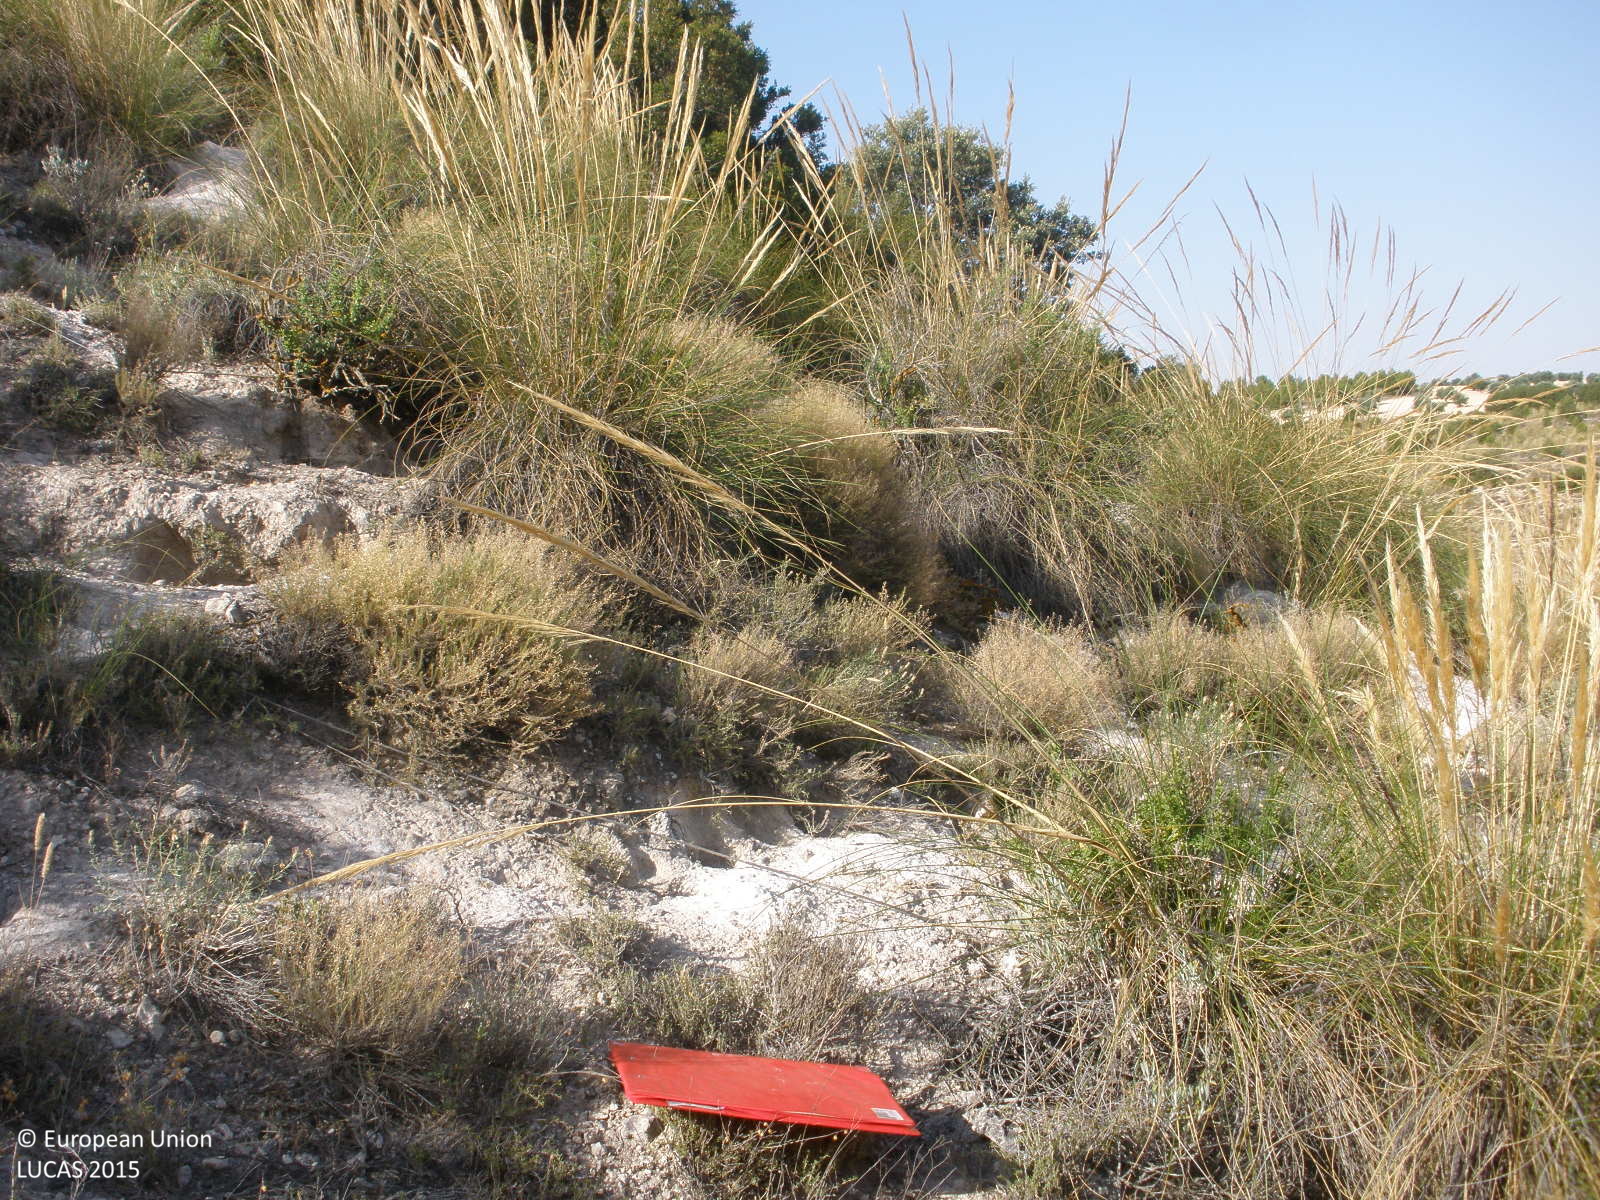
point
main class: Shrubland
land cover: Shrubland without tree cover
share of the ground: 50 - 75 %
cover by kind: shrubs 60 %, herbaceous plants 20 %, consolidated bare surface 20 %
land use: Semi-natural and natural areas not in use
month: July
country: ES
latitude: 39.9661
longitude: -3.2674
